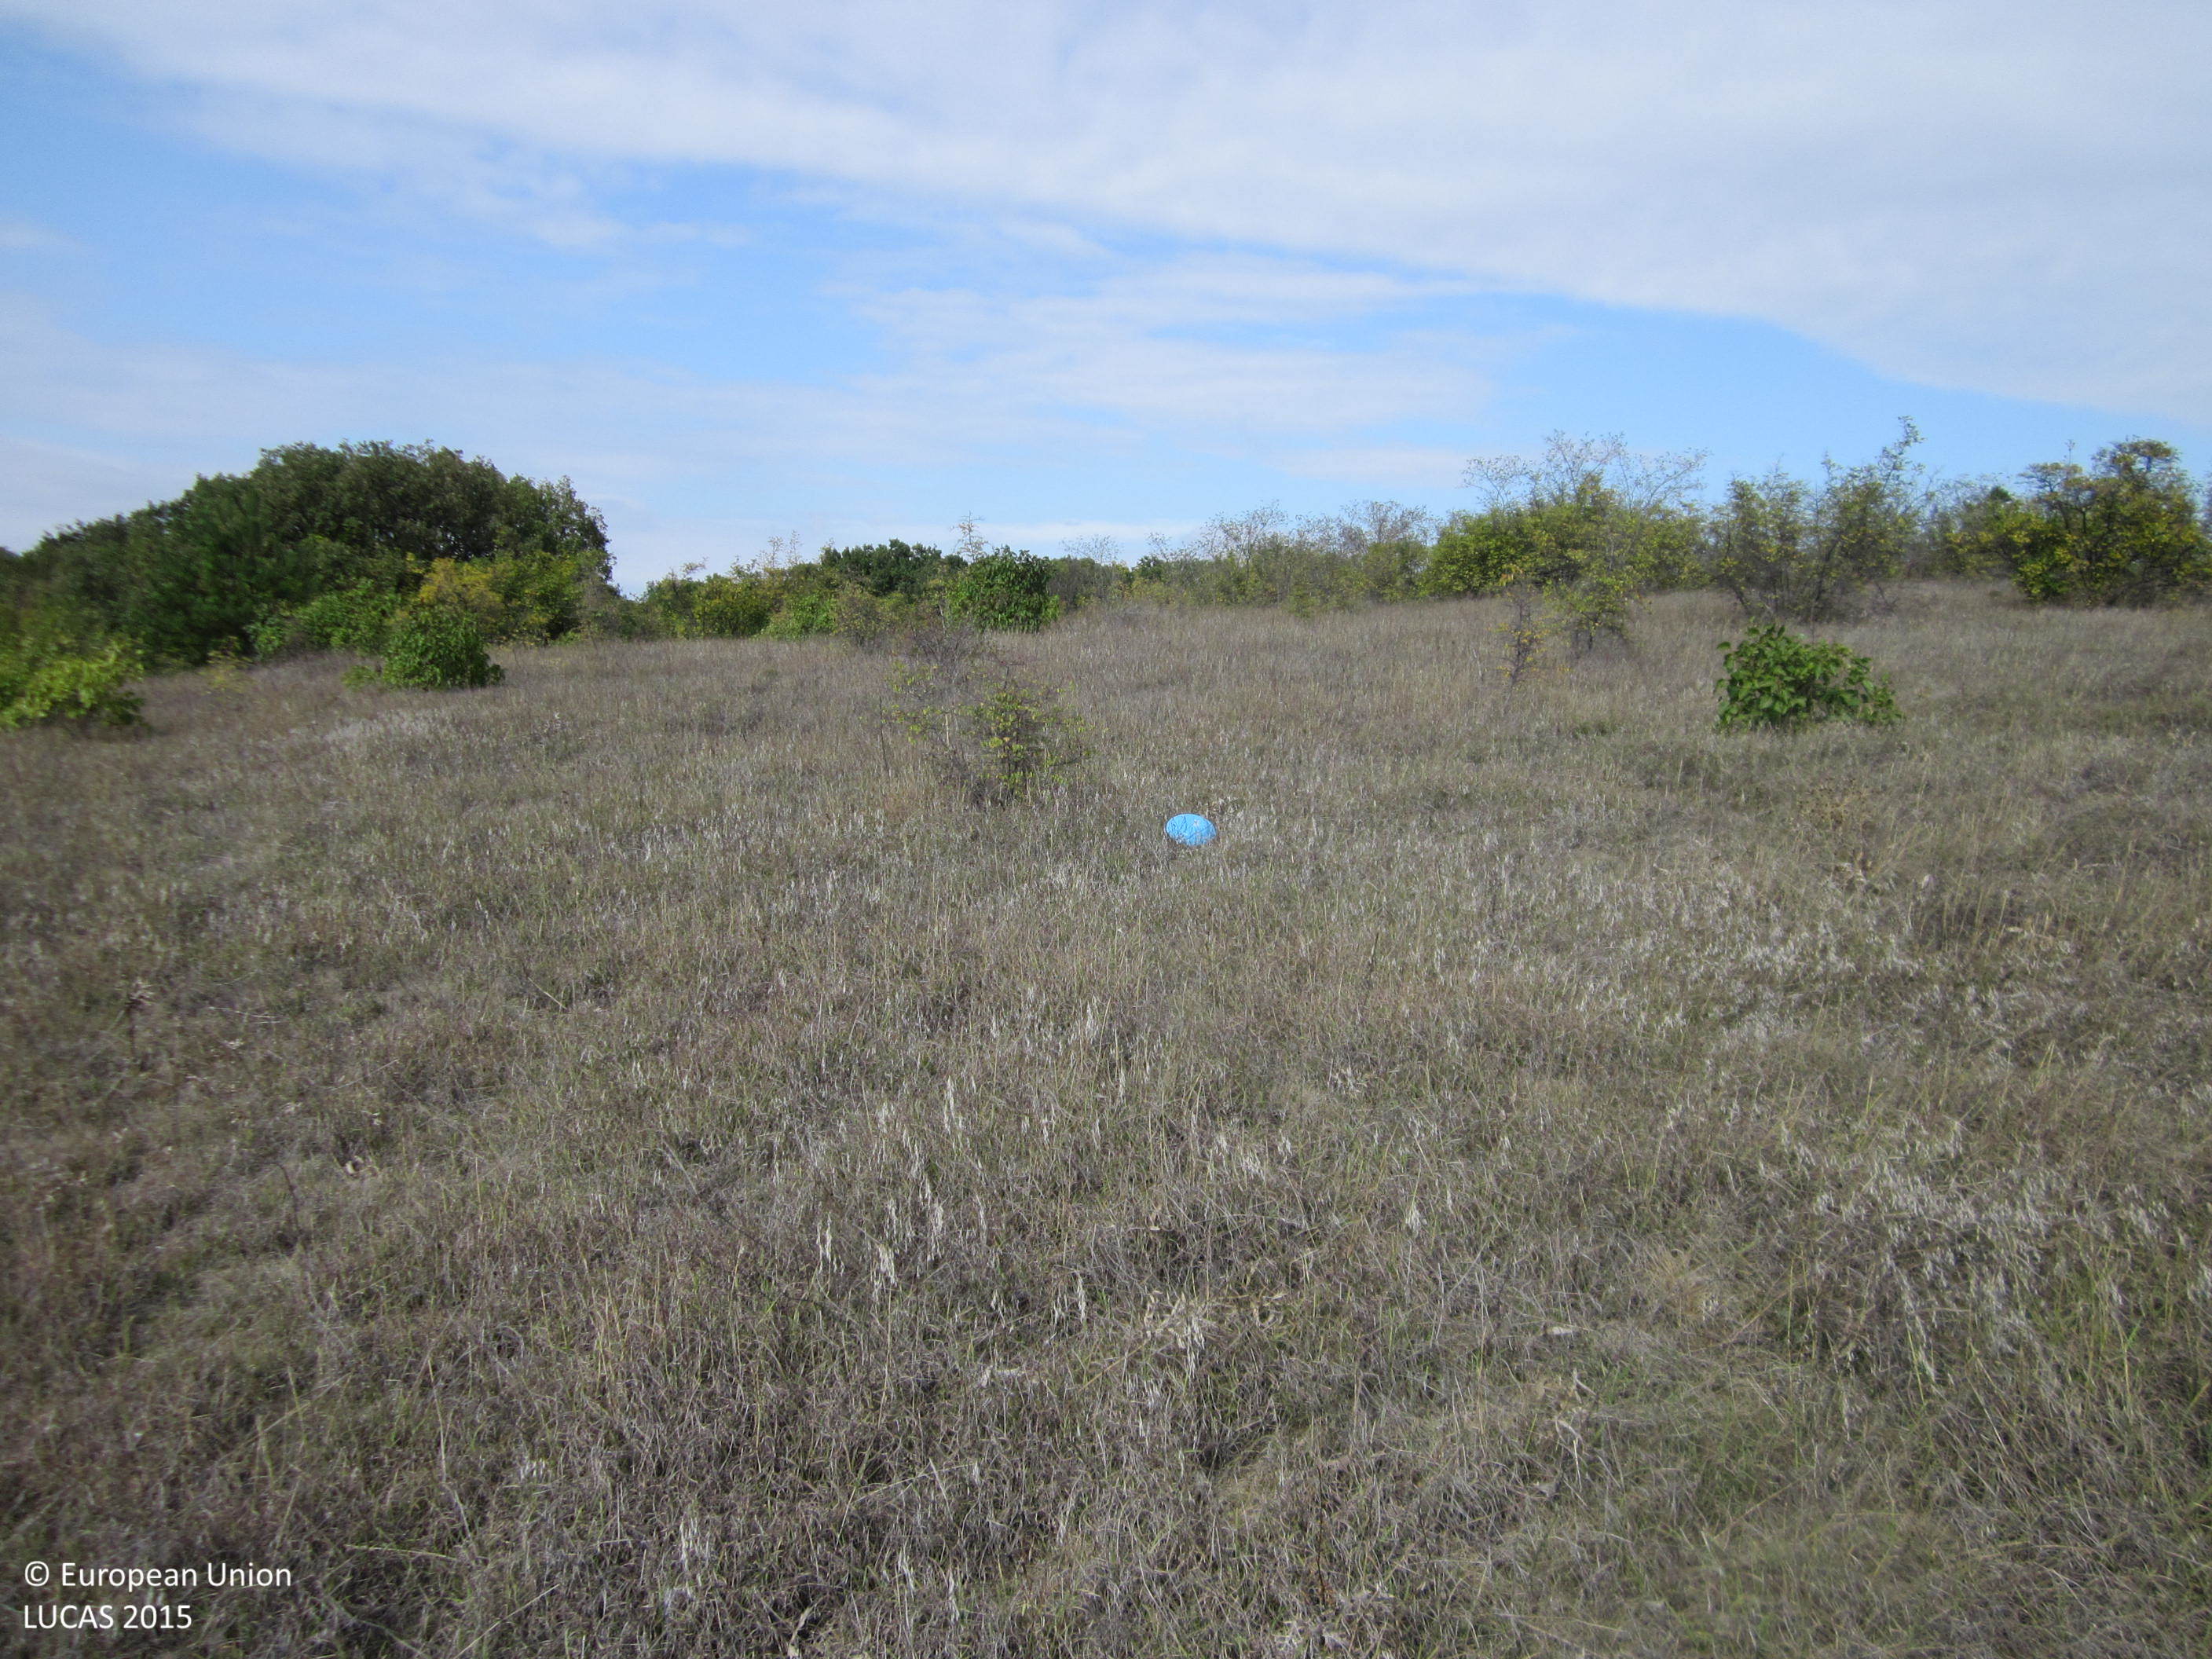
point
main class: Grassland
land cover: Grassland with sparse tree/shrub cover
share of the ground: > 75 %
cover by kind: herbaceous plants 90 %, coniferous forest trees 5 %, shrubs 5 %
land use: Semi-natural and natural areas not in use
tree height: < 5 m
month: October
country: BG
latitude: 42.6598
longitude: 26.7781
